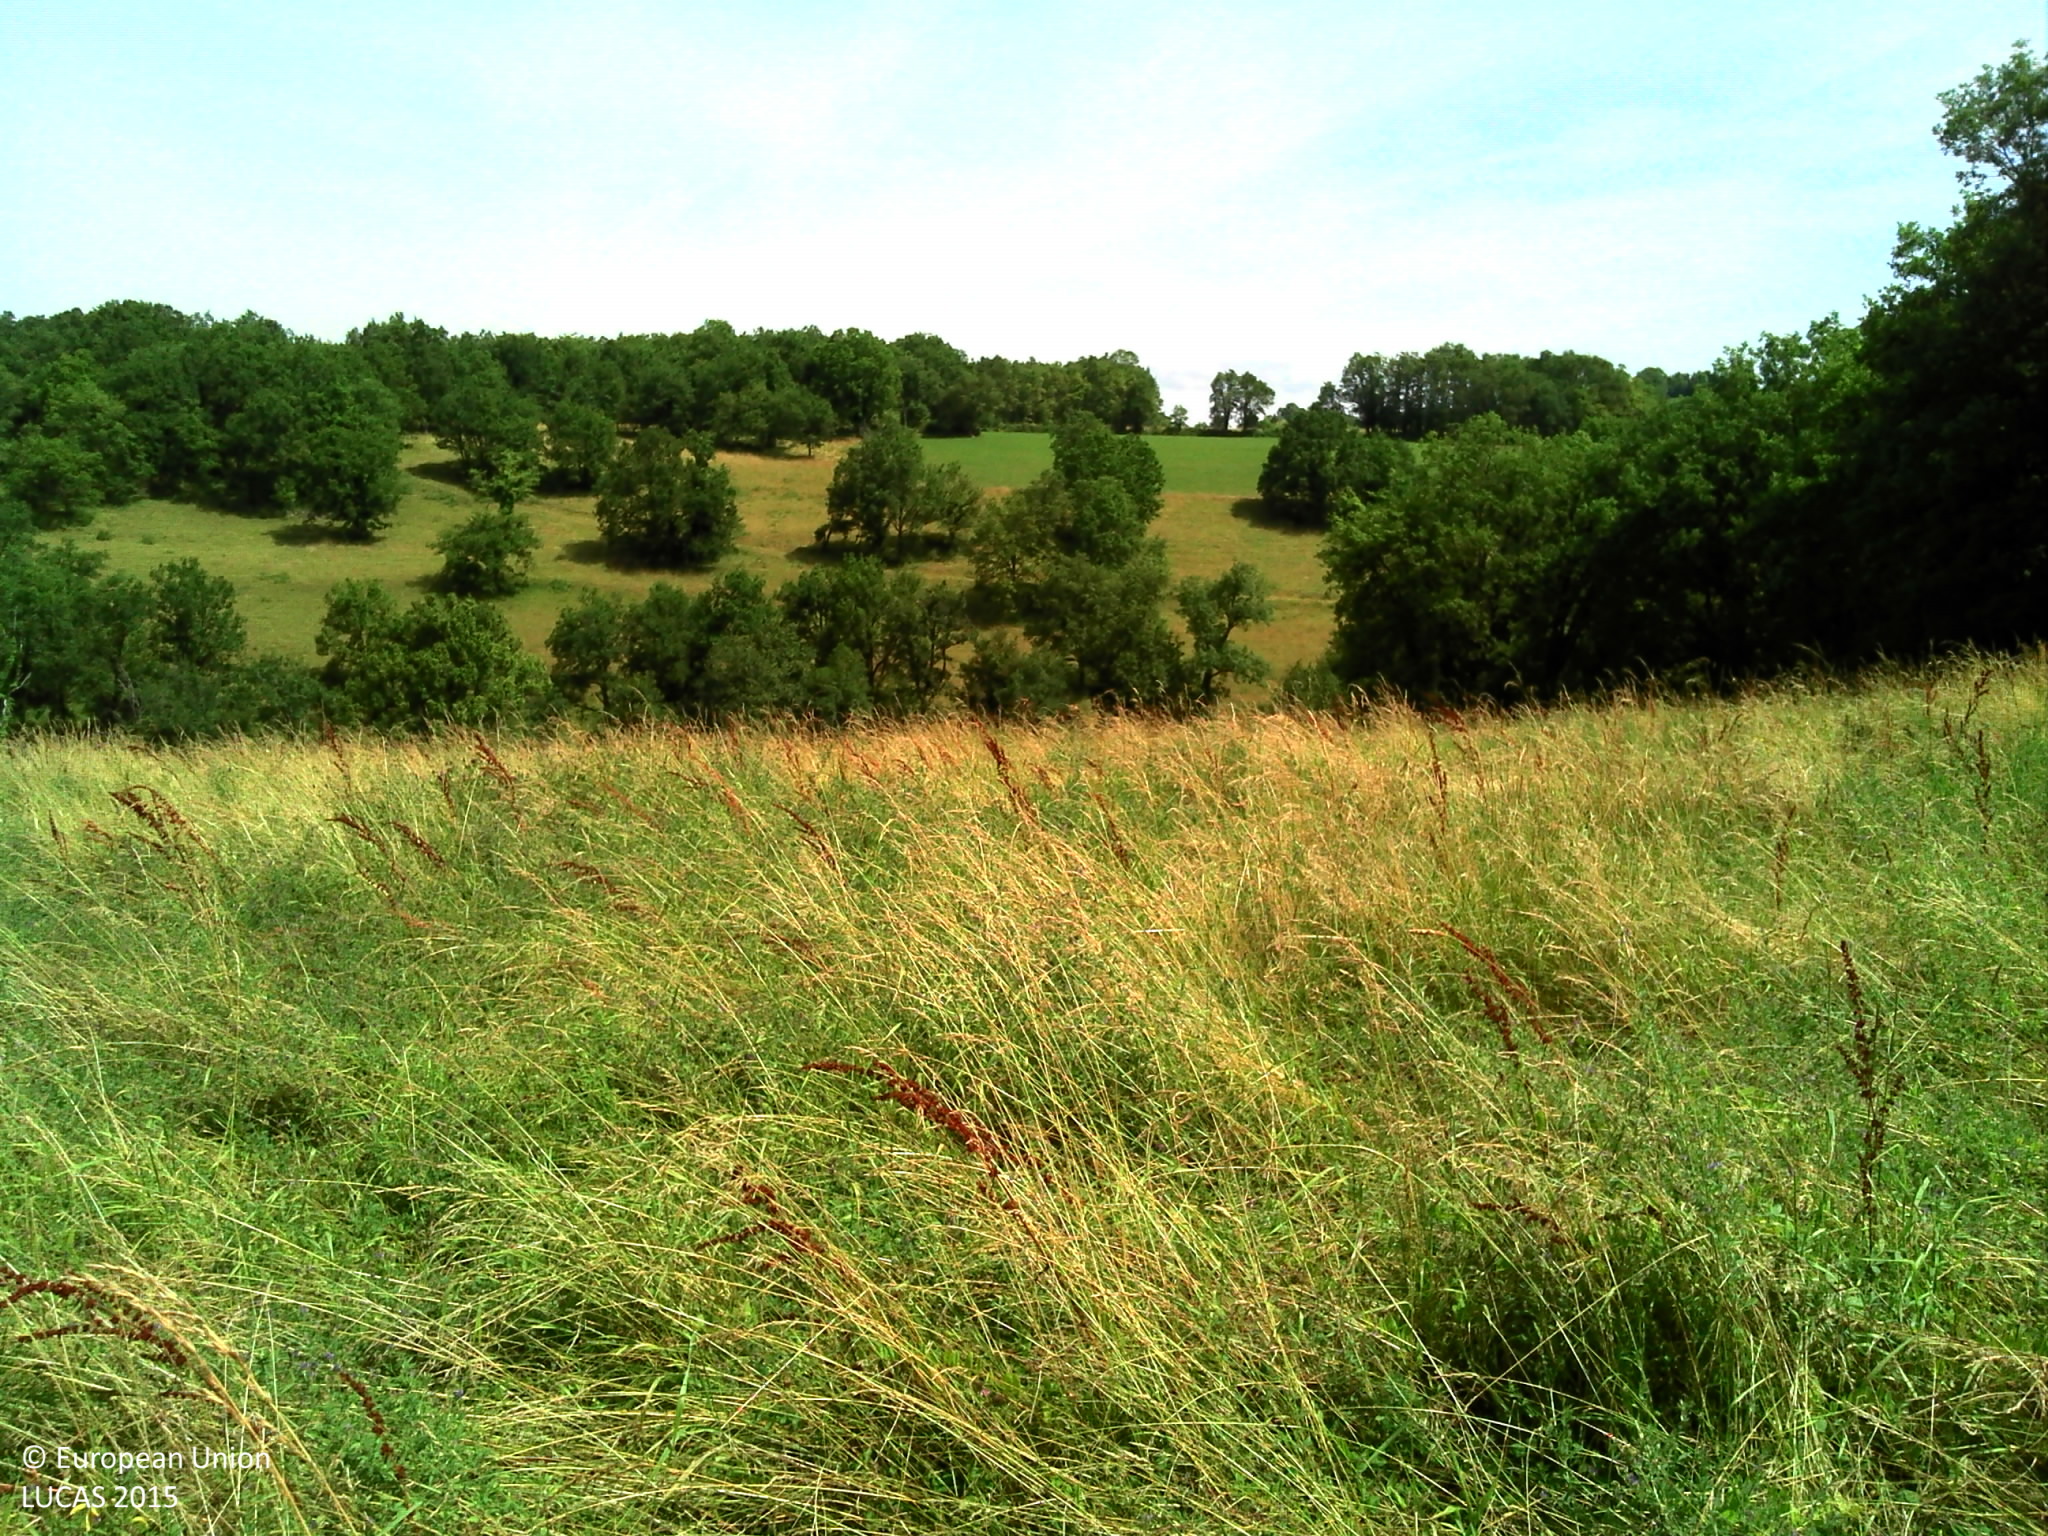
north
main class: Grassland
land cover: Grassland with sparse tree/shrub cover
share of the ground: > 75 %
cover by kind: herbaceous plants 95 %, broadleaved forest trees 5 %
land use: Agriculture (excluding fallow land and kitchen gardens)
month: June
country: FR
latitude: 44.5312
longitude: 2.0098
